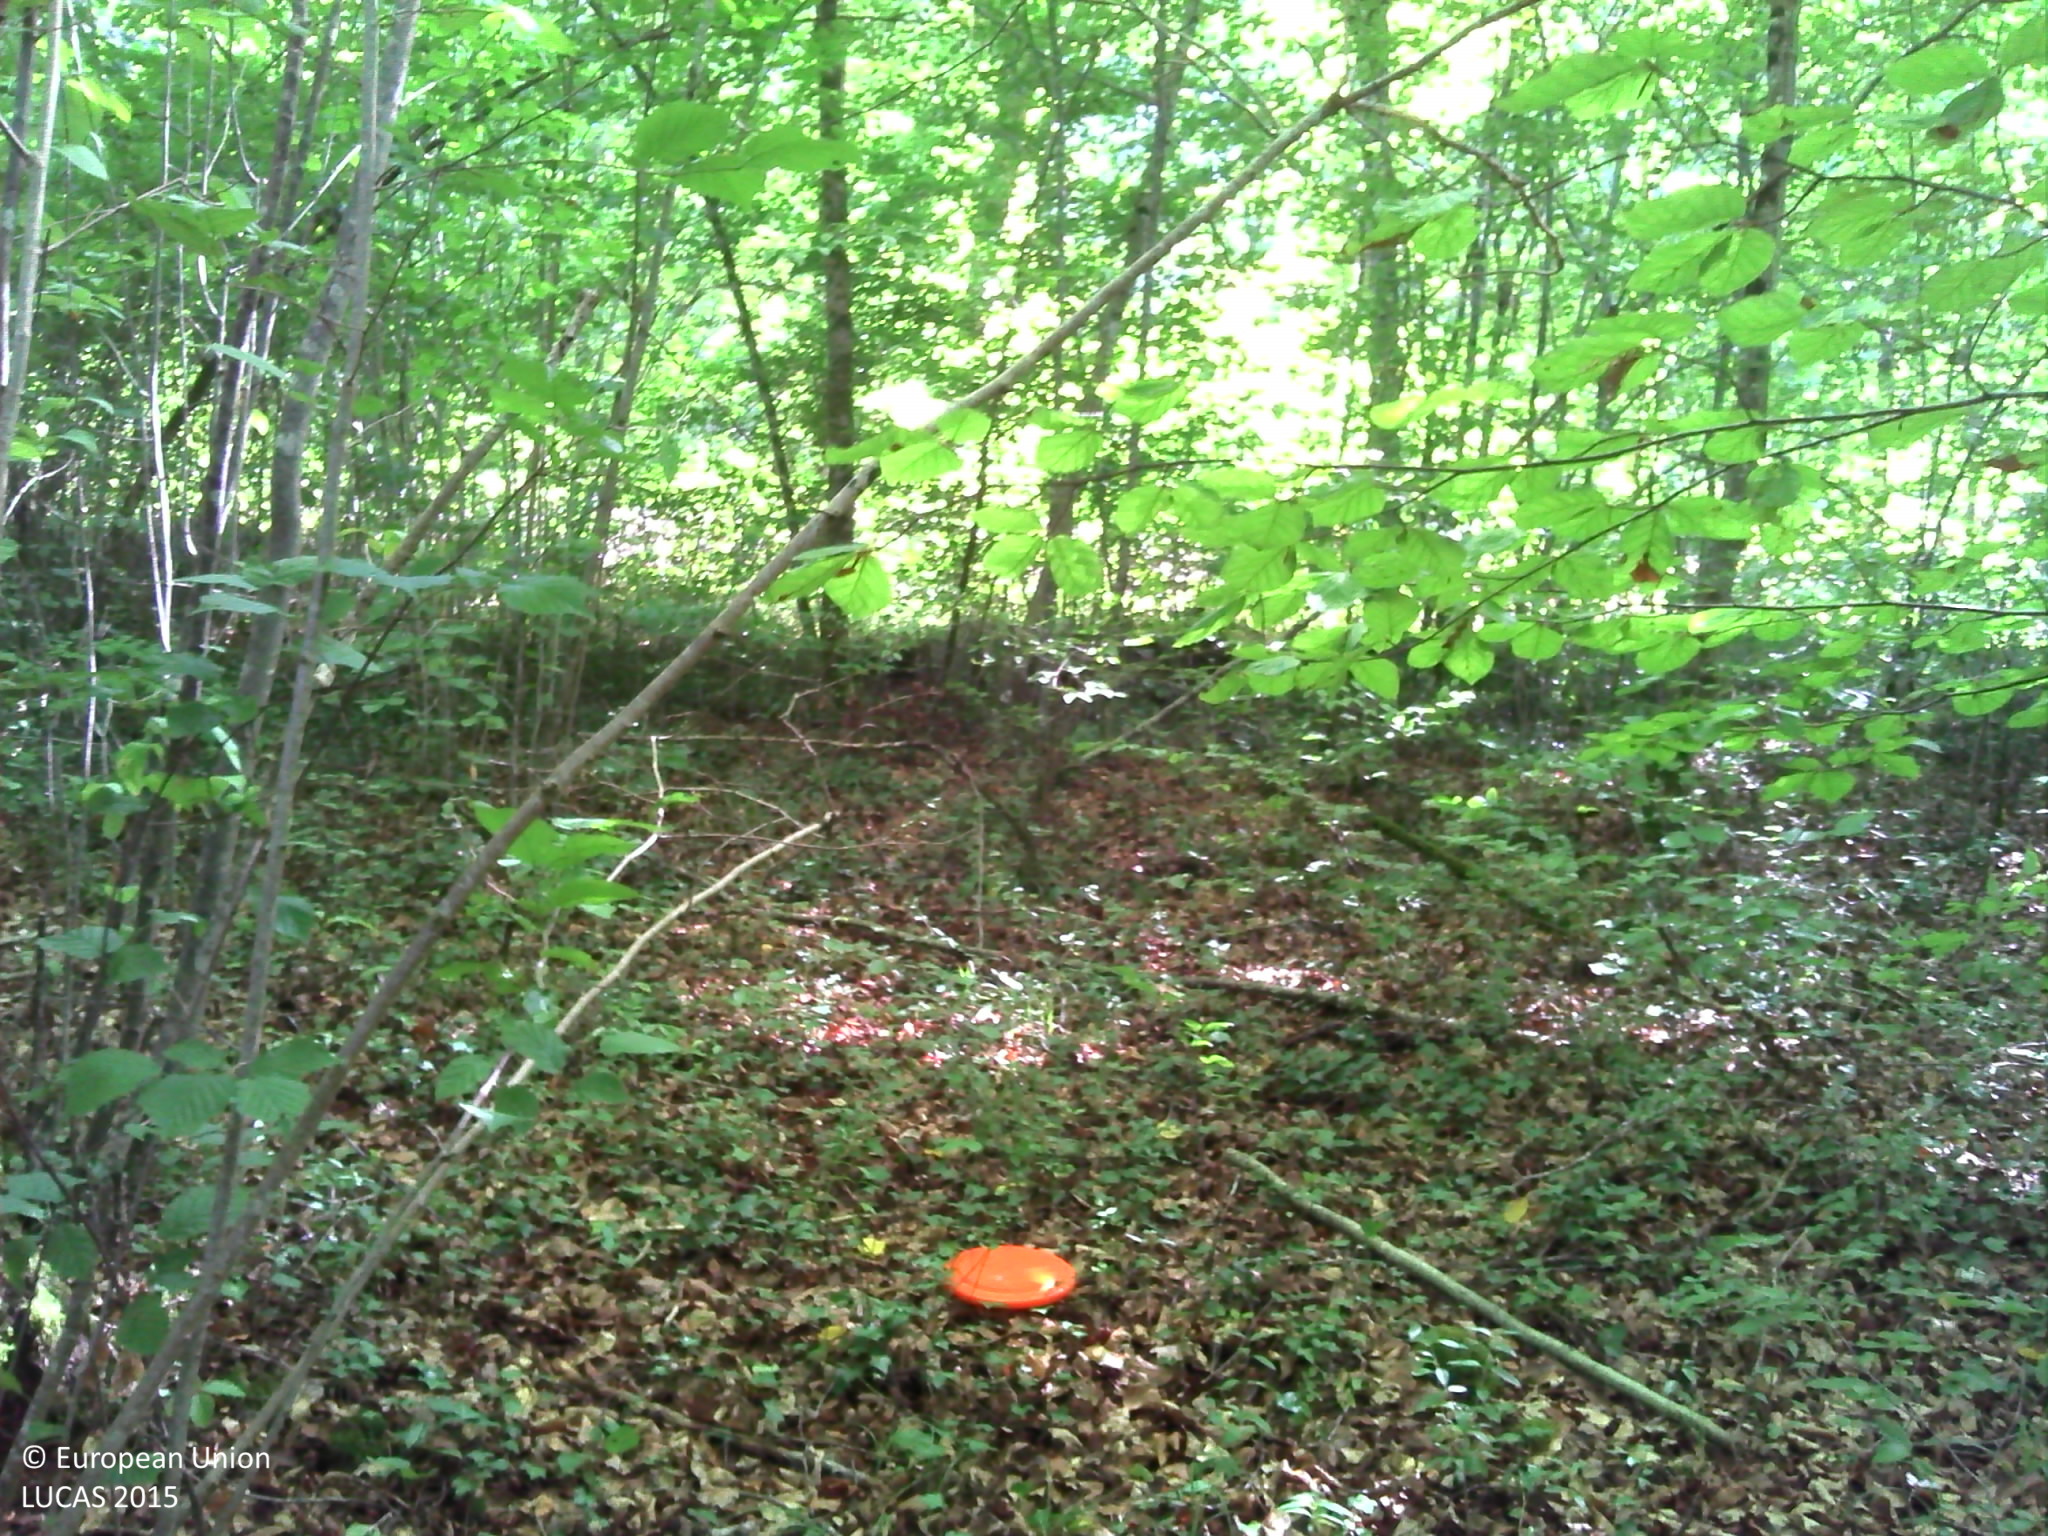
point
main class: Woodland
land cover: Broadleaved woodland
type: mesophytic deciduous forest
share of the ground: > 75 %
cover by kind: broadleaved forest trees 90 %, herbaceous plants 5 %, lichens and mosses 5 %
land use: Forestry
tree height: > 5 m
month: August
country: FR
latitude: 47.8343
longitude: 4.8824
